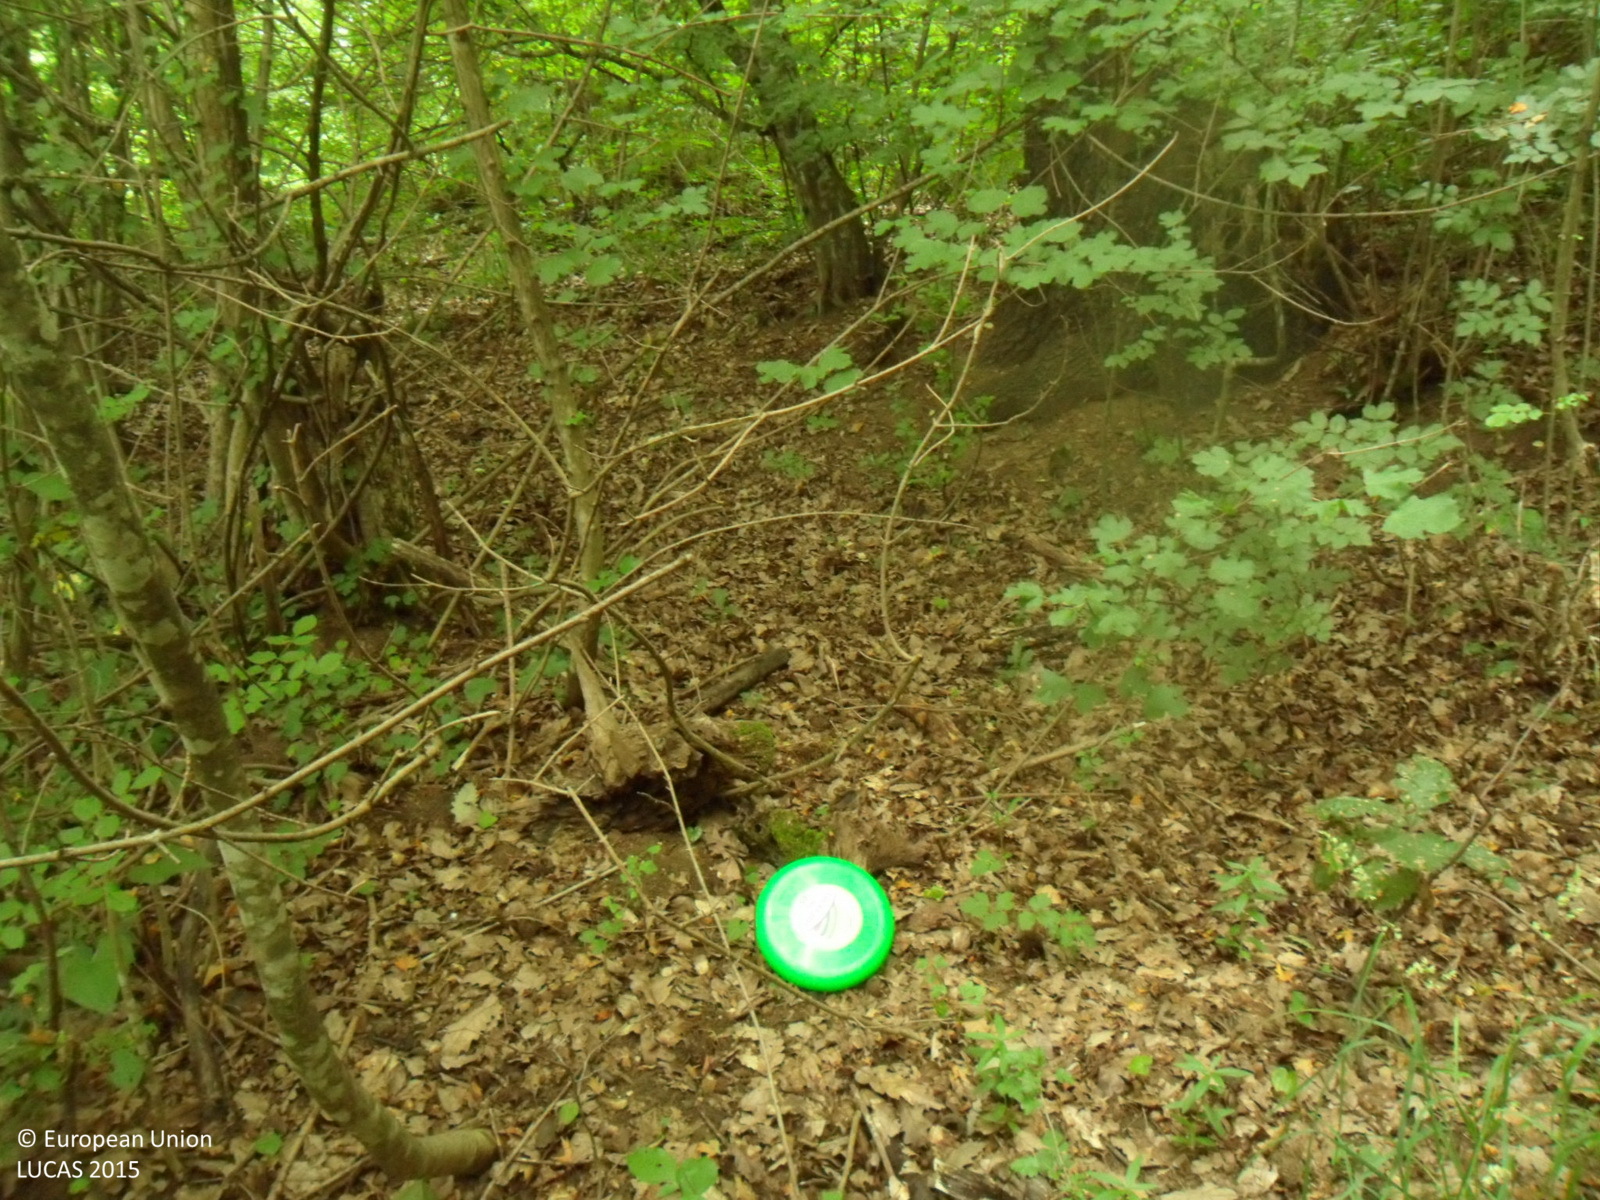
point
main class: Woodland
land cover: Broadleaved woodland
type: mesophytic deciduous forest
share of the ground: > 75 %
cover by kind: broadleaved forest trees 100 %
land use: Forestry
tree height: > 5 m
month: June
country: BG
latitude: 43.0943
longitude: 26.9294
